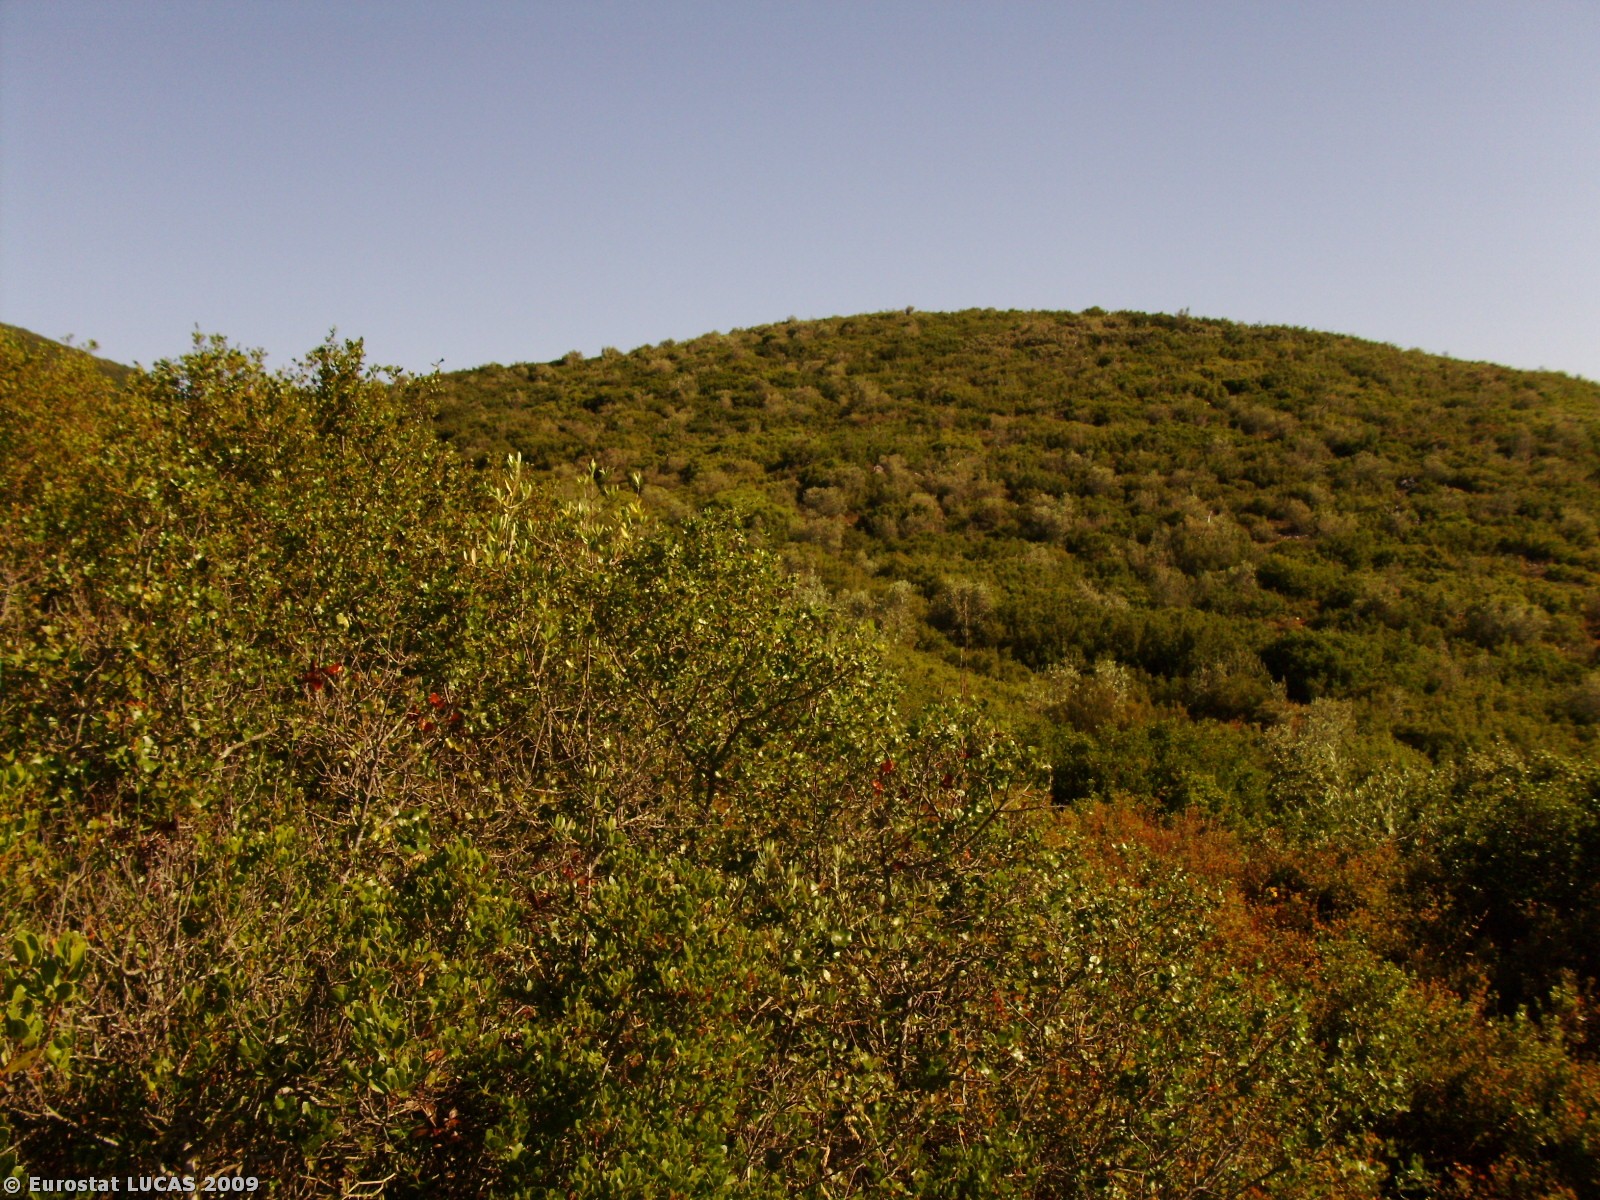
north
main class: Shrubland
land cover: Shrubland with sparse tree cover
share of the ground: > 75 %
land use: Unused
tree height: > 5 m
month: June
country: PT
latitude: 39.9928
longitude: -8.3844
